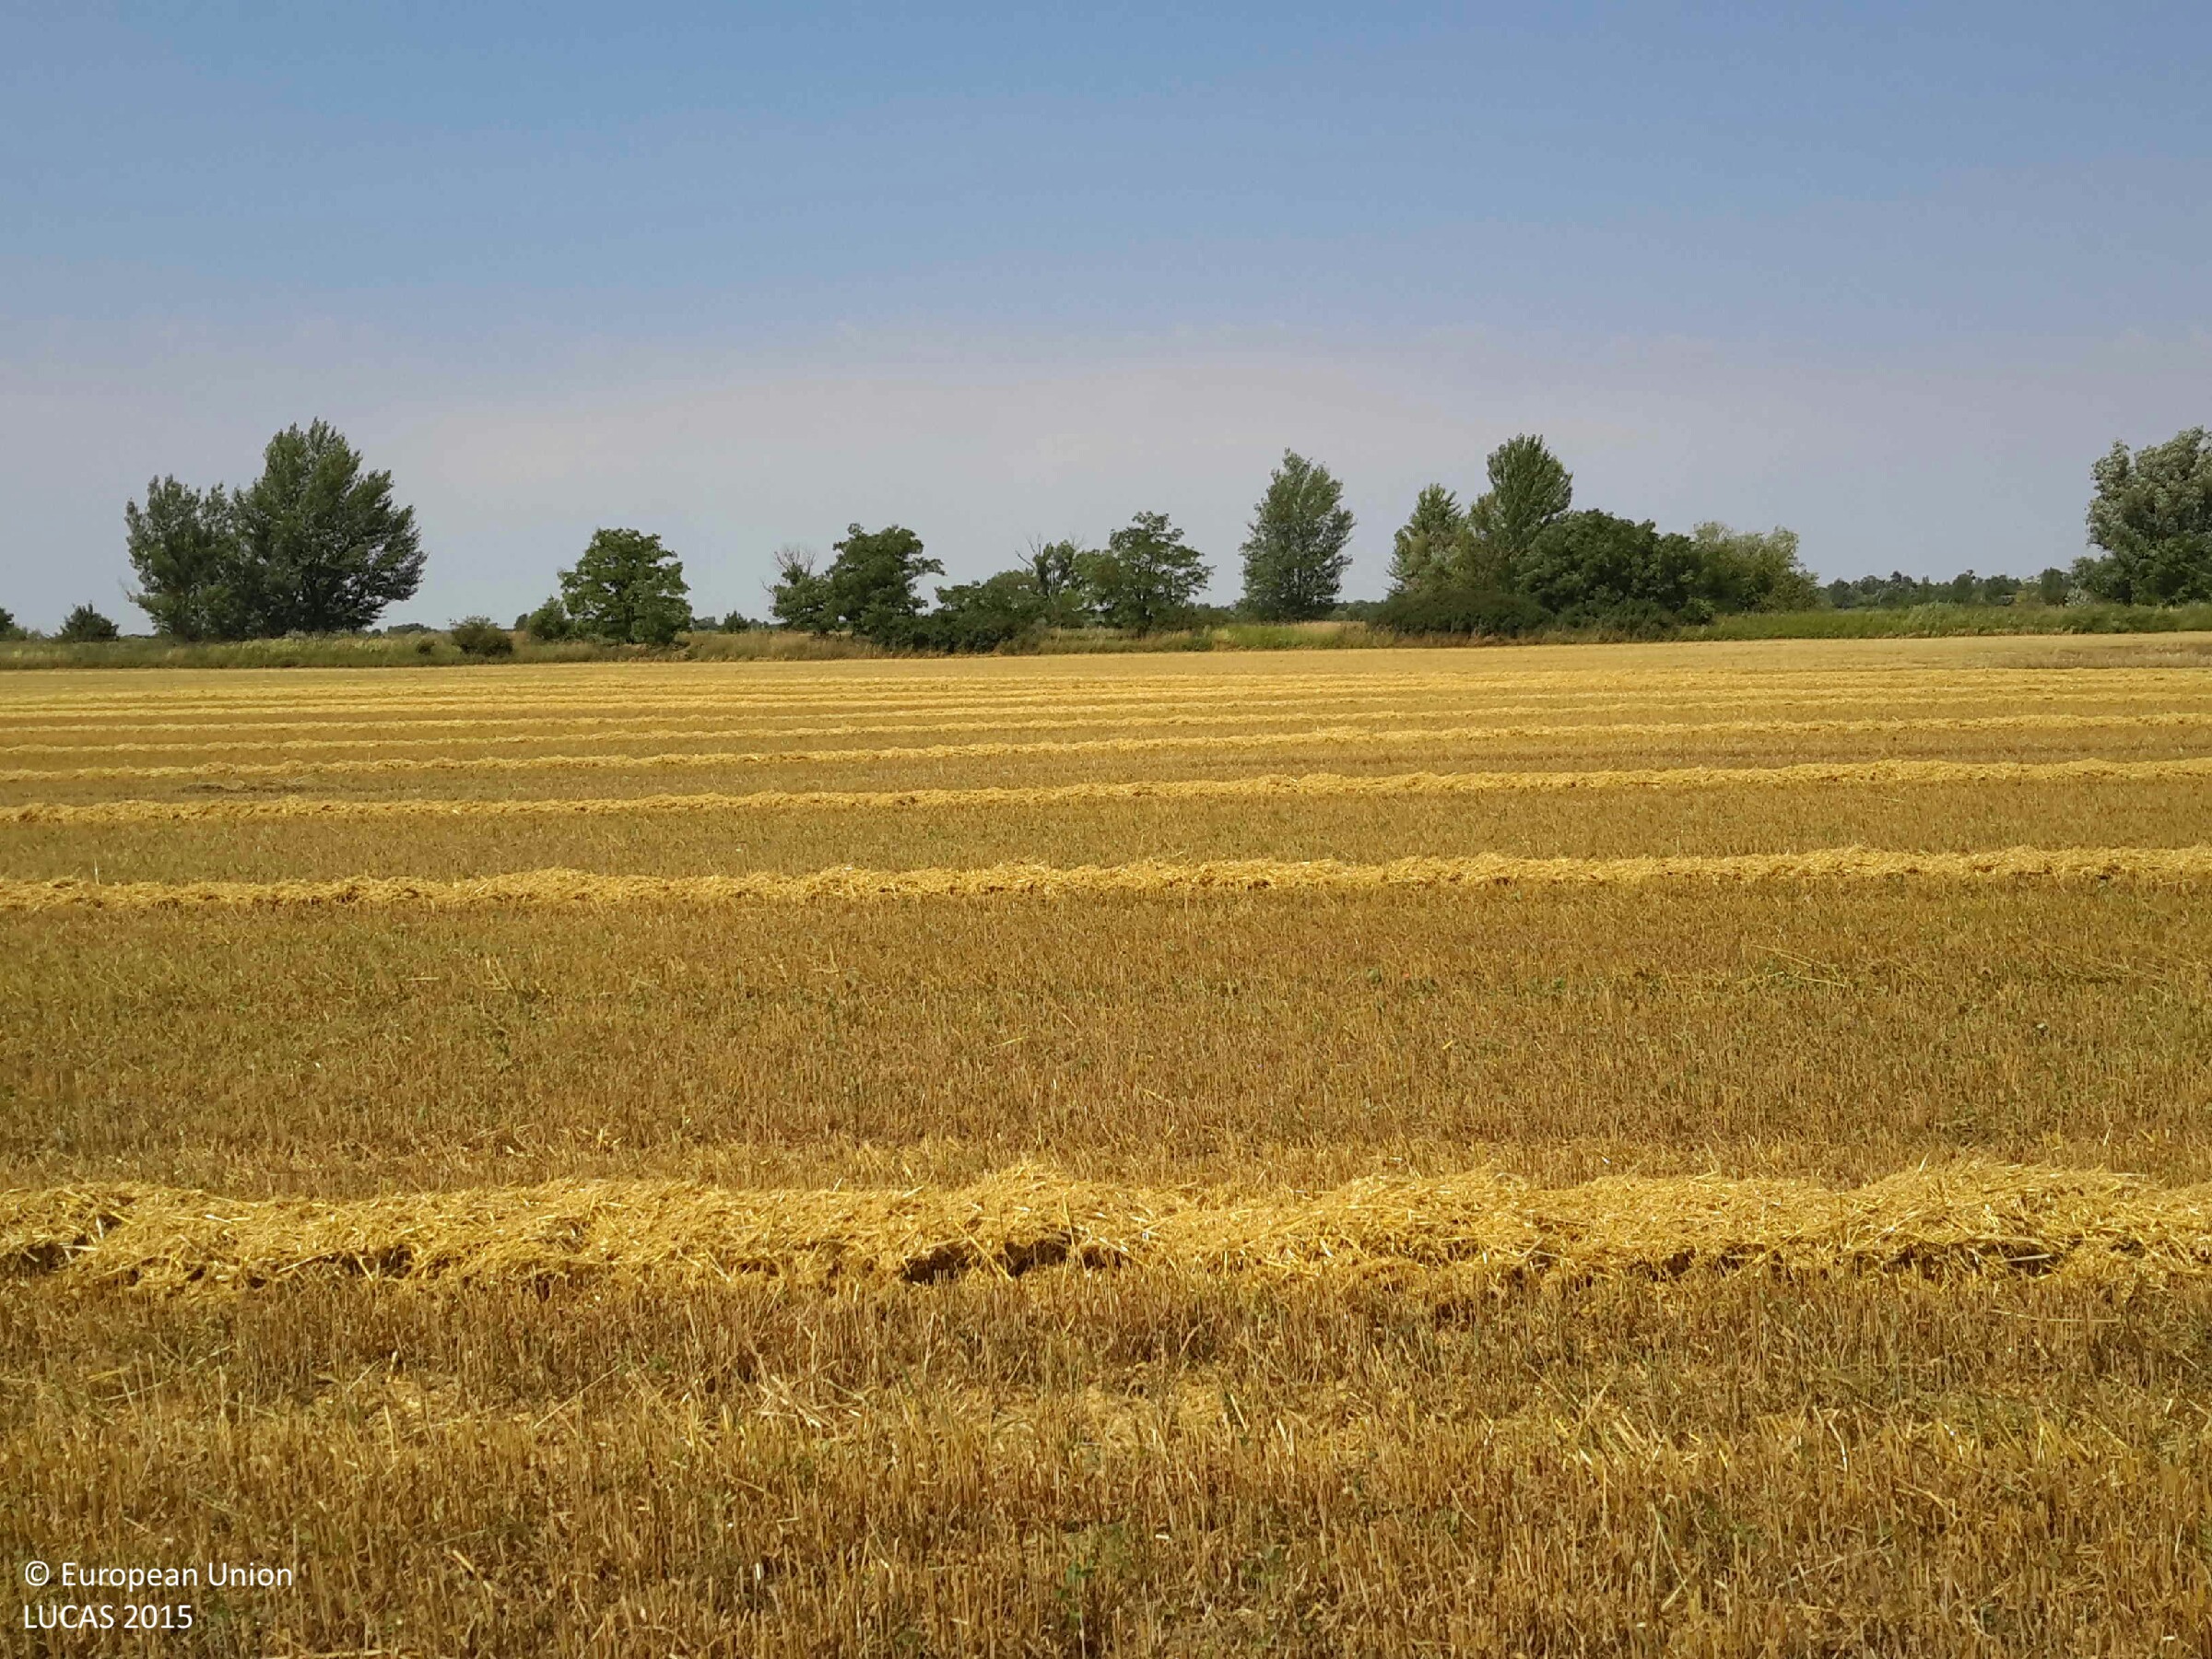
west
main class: Cropland
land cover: Barley
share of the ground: 25 - 50 %
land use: Agriculture (excluding fallow land and kitchen gardens)
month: July
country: HU
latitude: 47.3471
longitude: 17.3268
